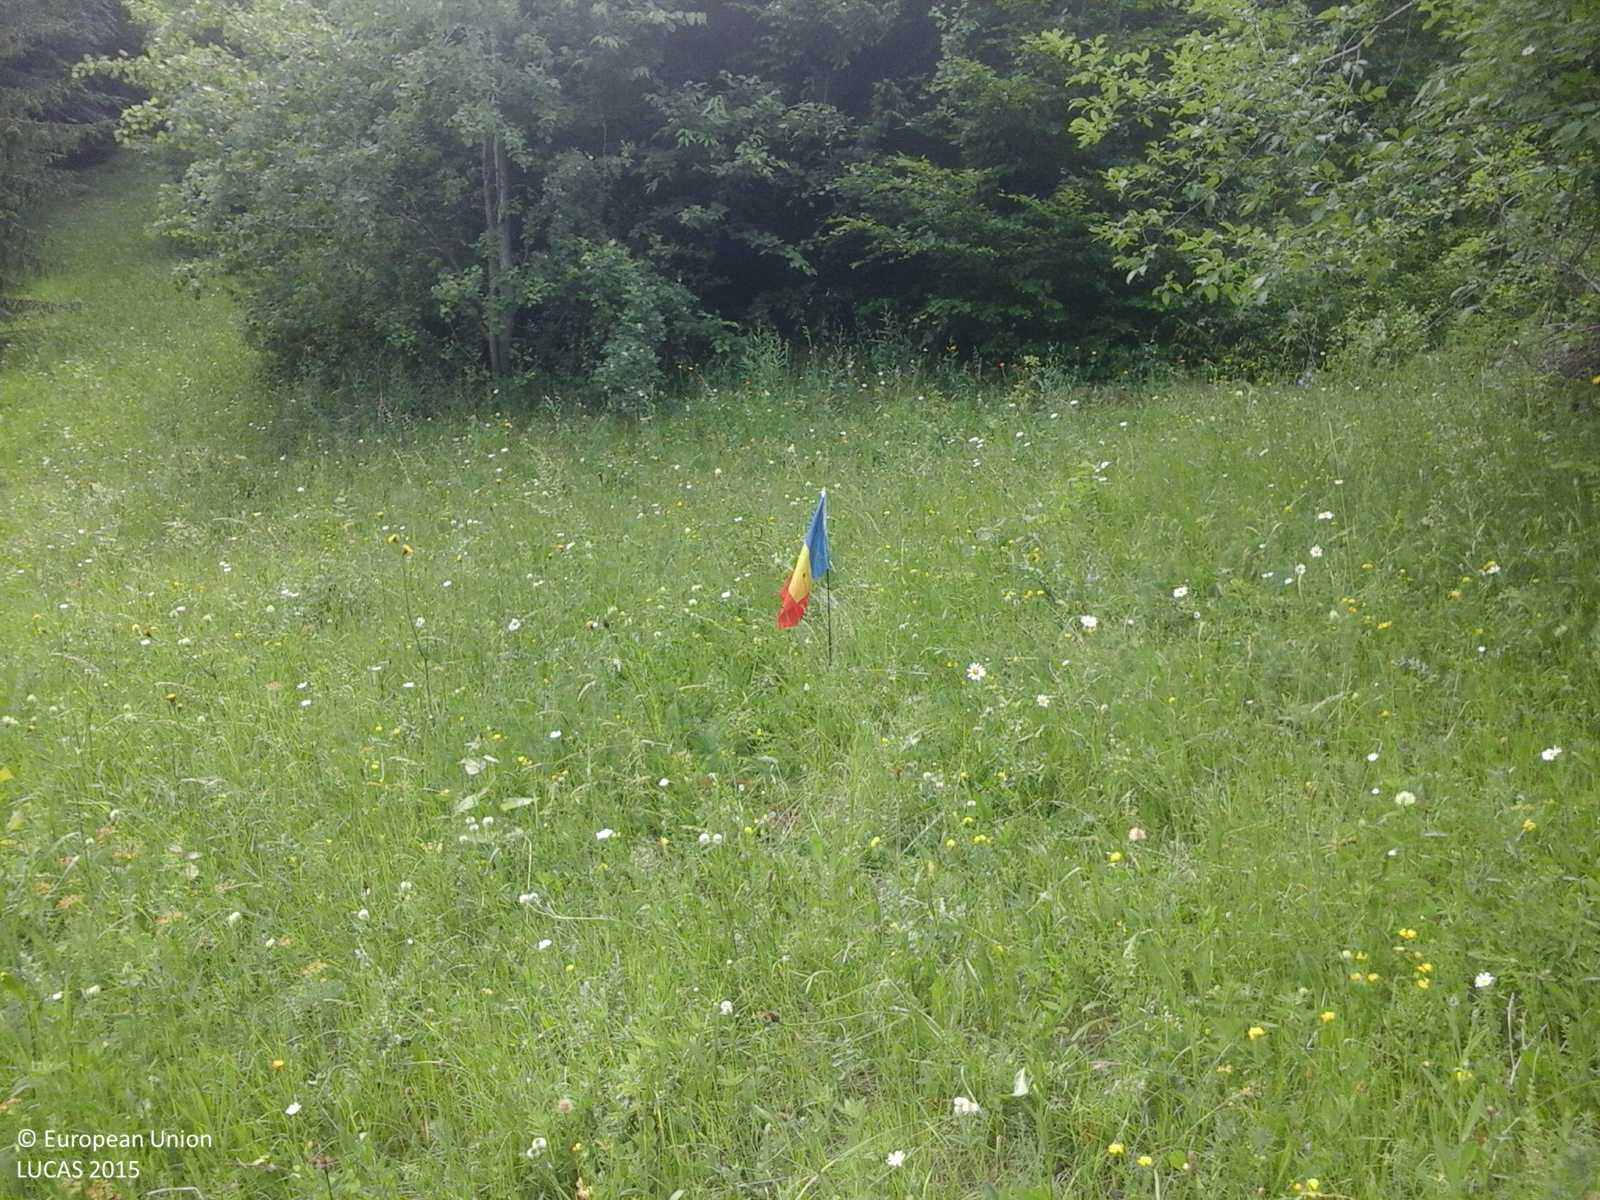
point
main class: Woodland
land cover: Spruce dominated mixed woodland
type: alpine coniferous forest
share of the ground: 50 - 75 %
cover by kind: coniferous forest trees 75 %, broadleaved forest trees 25 %
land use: Forestry
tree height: > 5 m
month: June
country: RO
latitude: 47.6480
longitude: 25.7659
